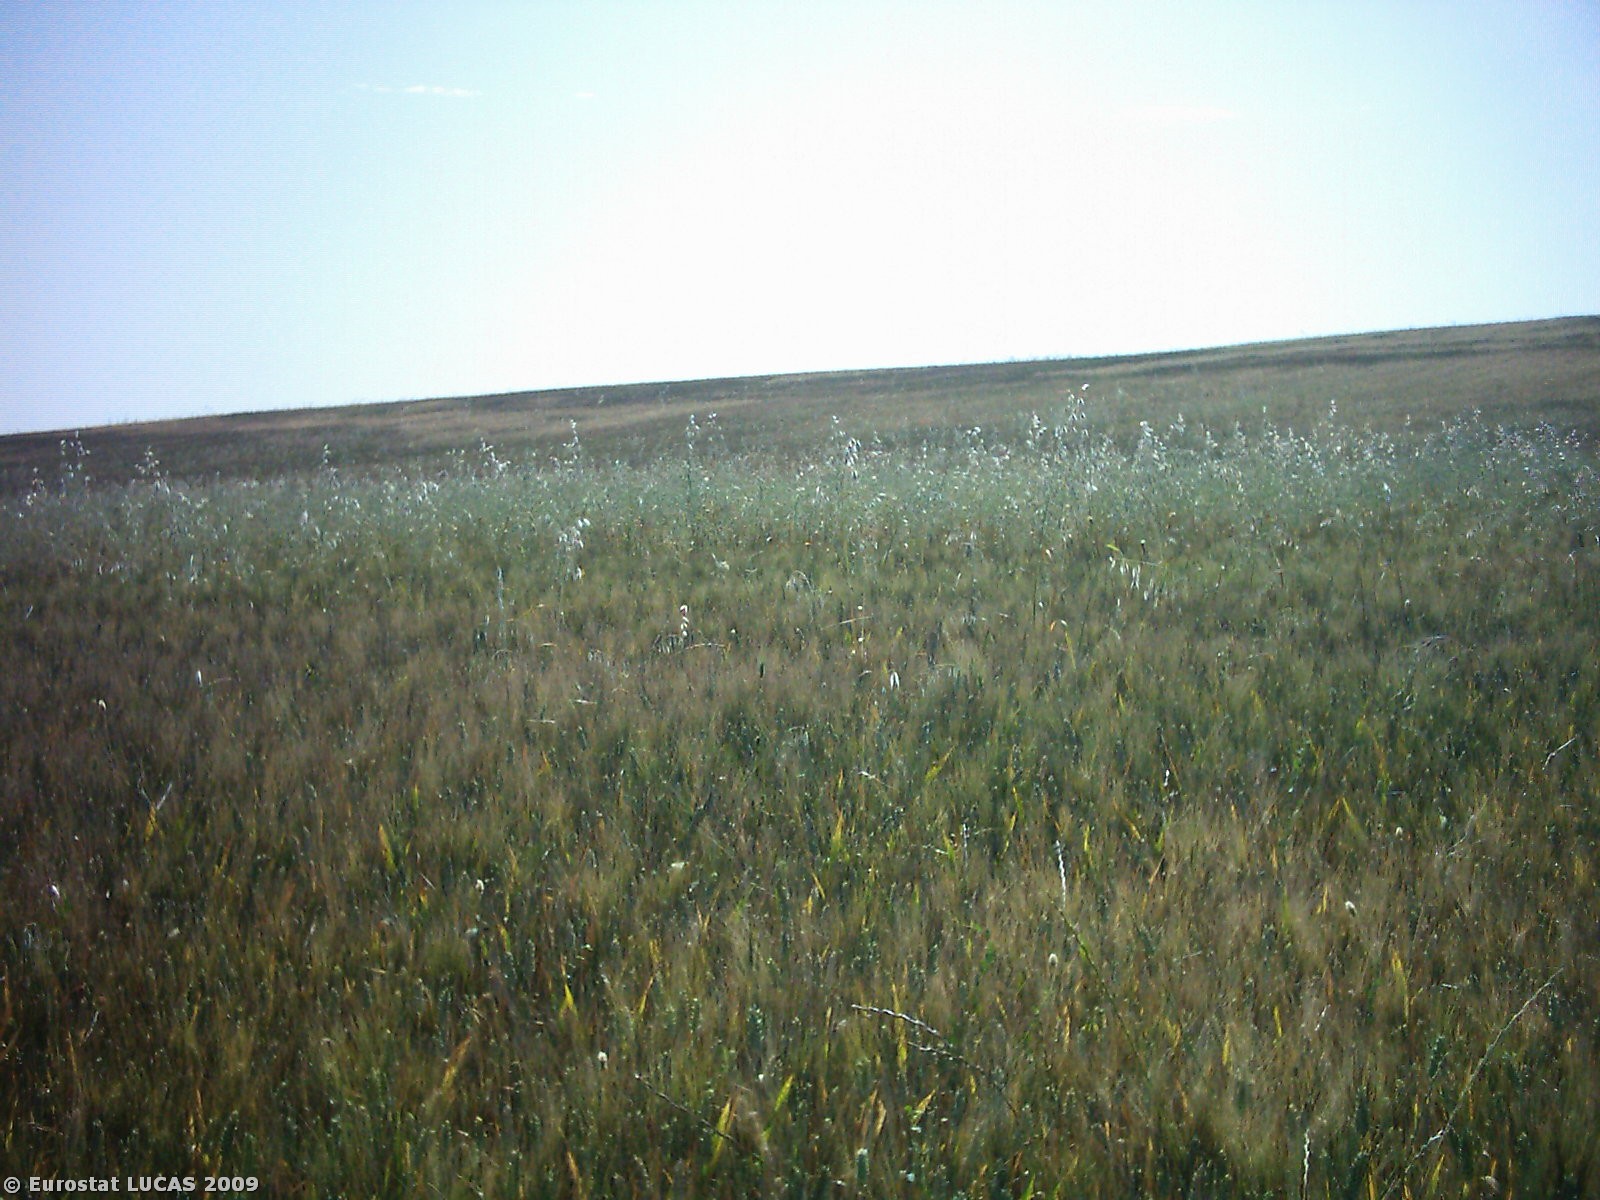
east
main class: Cropland
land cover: Durum wheat
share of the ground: > 75 %
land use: Agriculture (excluding fallow land and kitchen gardens)
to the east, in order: Durum wheat; Artificial constructions in urban areas; Durum wheat
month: May
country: IT
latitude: 41.3202
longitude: 15.6319
